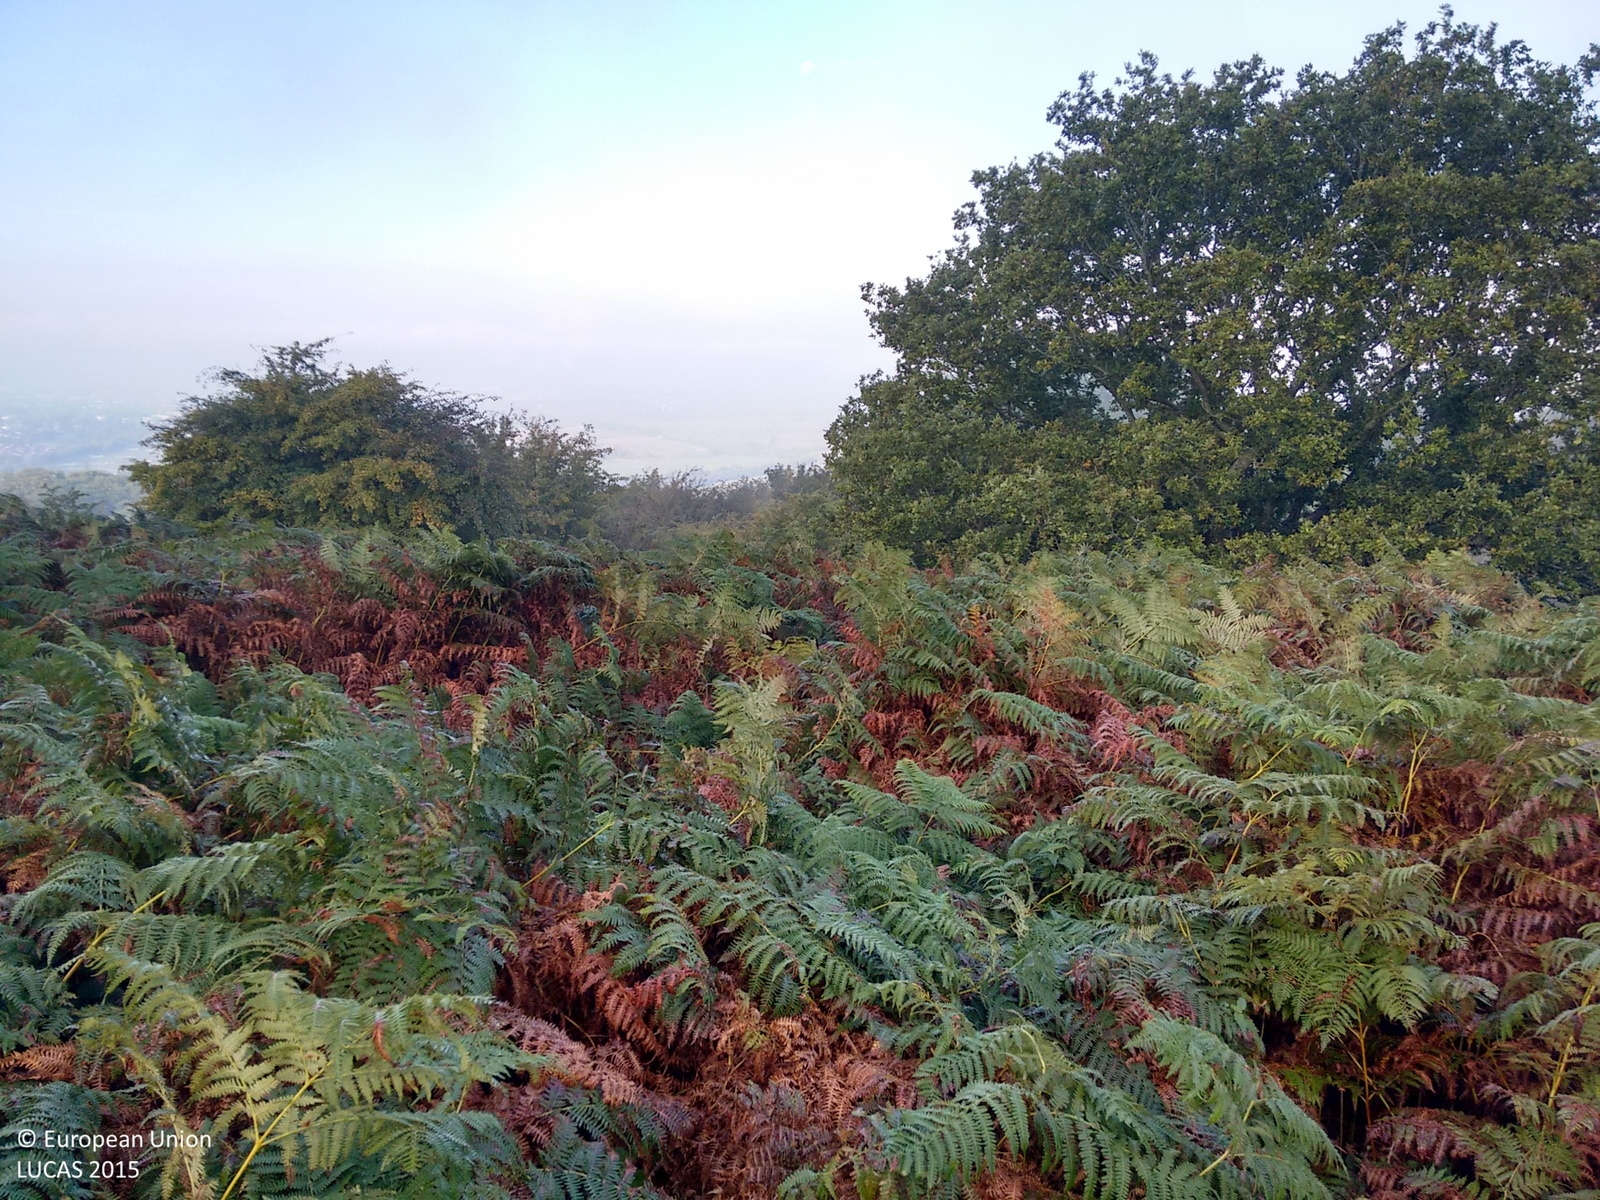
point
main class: Shrubland
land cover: Shrubland with sparse tree cover
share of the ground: > 75 %
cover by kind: herbaceous plants 60 %, shrubs 35 %, broadleaved forest trees 5 %
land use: Agriculture (excluding fallow land and kitchen gardens)
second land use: Community services
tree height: < 5 m
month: September
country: GB
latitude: 51.9270
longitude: -2.0270
